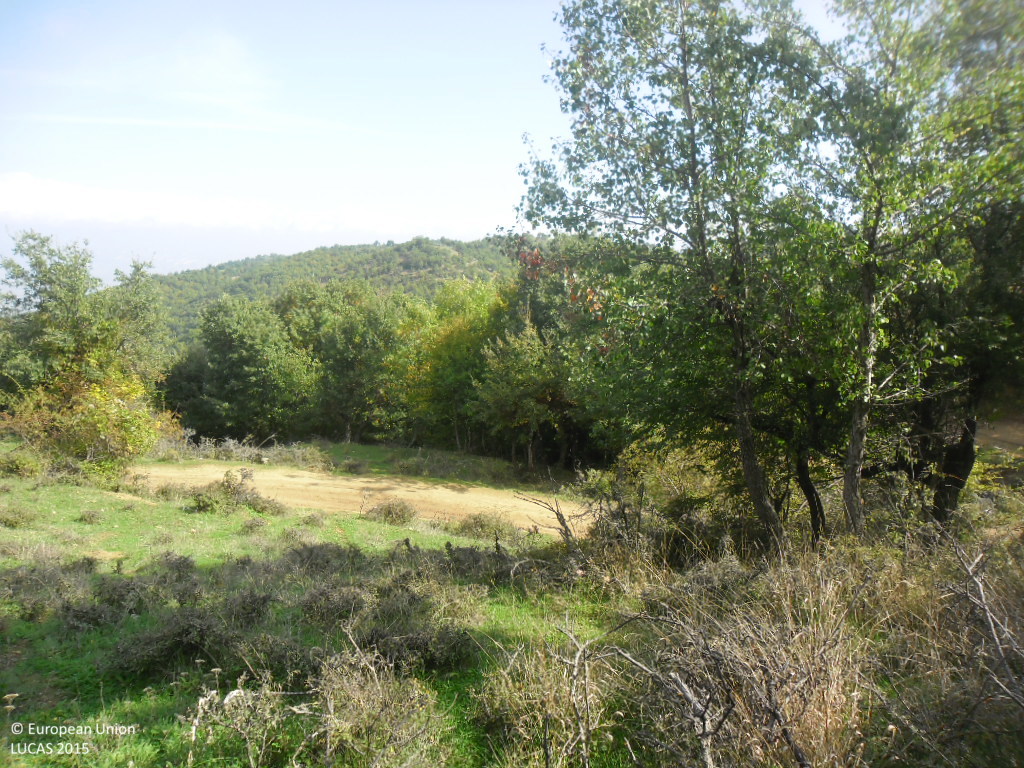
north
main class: Woodland
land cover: Broadleaved woodland
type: mesophytic deciduous forest
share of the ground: > 75 %
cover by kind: broadleaved forest trees 75 %, shrubs 10 %, herbaceous plants 10 %, unconsolidated bare surface 5 %
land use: Forestry
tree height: < 5 m
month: October
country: BG
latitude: 41.5133
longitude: 23.1882
